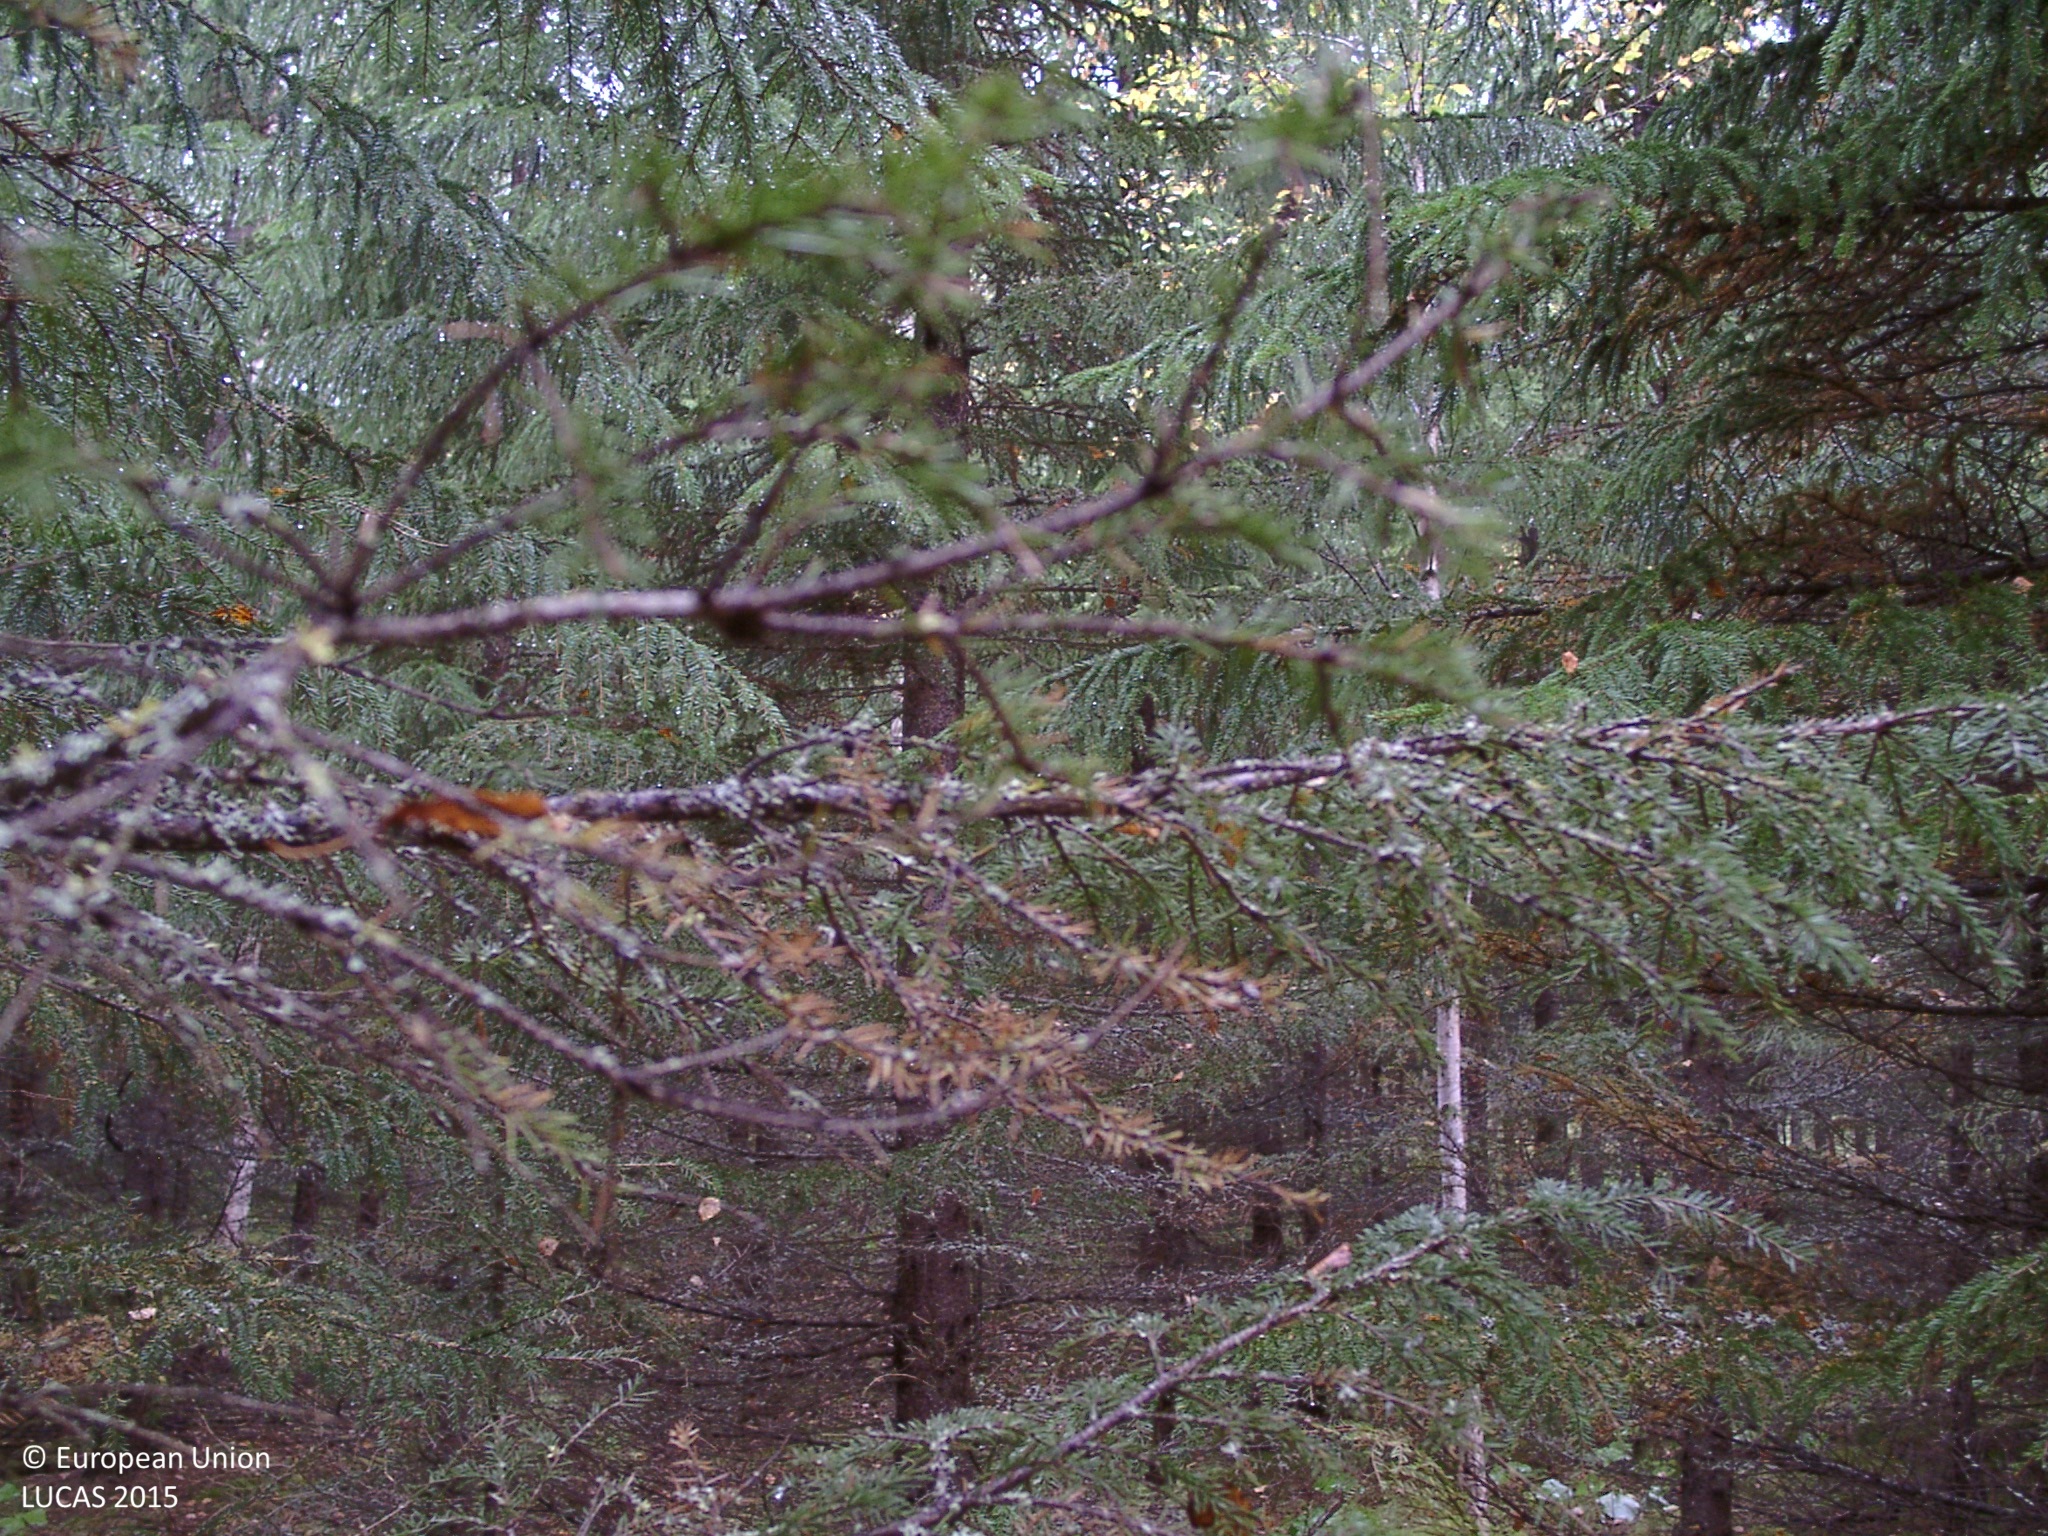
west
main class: Woodland
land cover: Spruce dominated mixed woodland
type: boreal forest
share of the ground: > 75 %
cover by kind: coniferous forest trees 60 %, broadleaved forest trees 25 %, herbaceous plants 5 %, lichens and mosses 5 %
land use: Forestry
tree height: > 5 m
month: September
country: FI
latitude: 62.6211
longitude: 25.6090
